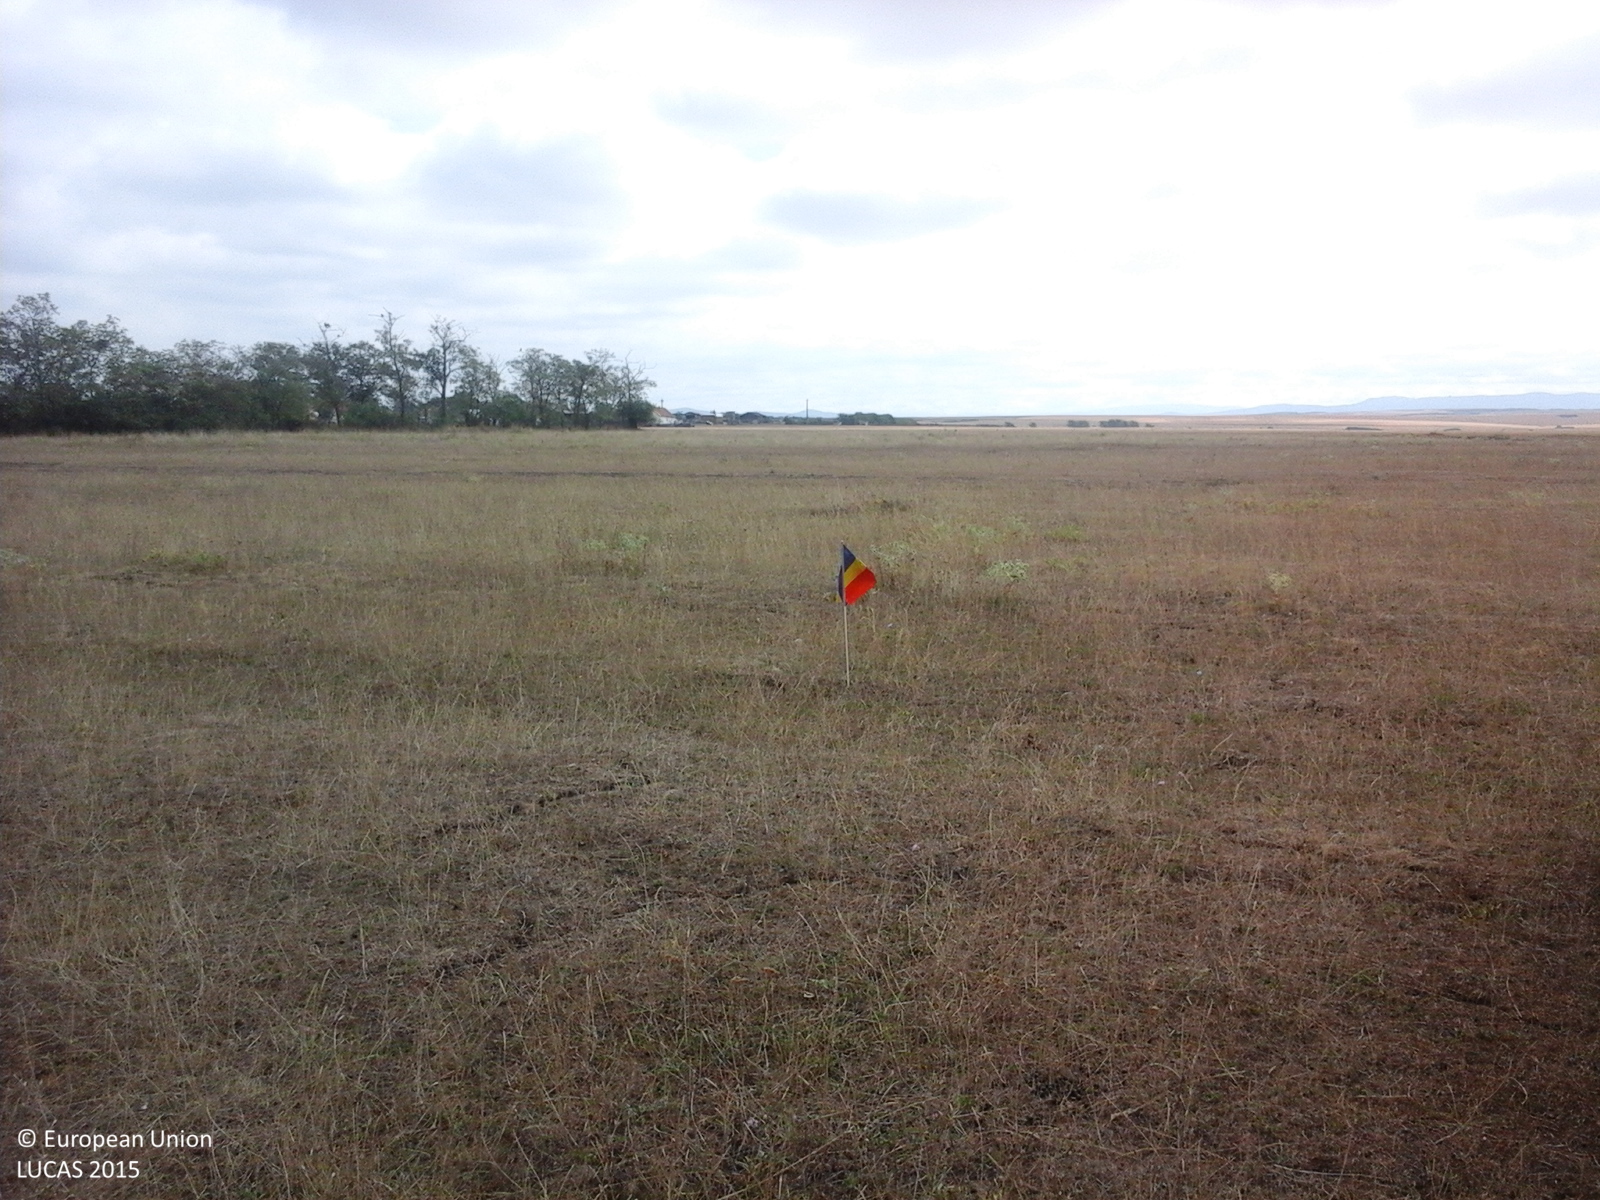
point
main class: Grassland
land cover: Grassland without tree/shrub cover
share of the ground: > 75 %
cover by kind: herbaceous plants 100 %
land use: Agriculture (excluding fallow land and kitchen gardens)
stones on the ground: < 10 %
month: August
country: RO
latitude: 45.4023
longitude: 21.4913
